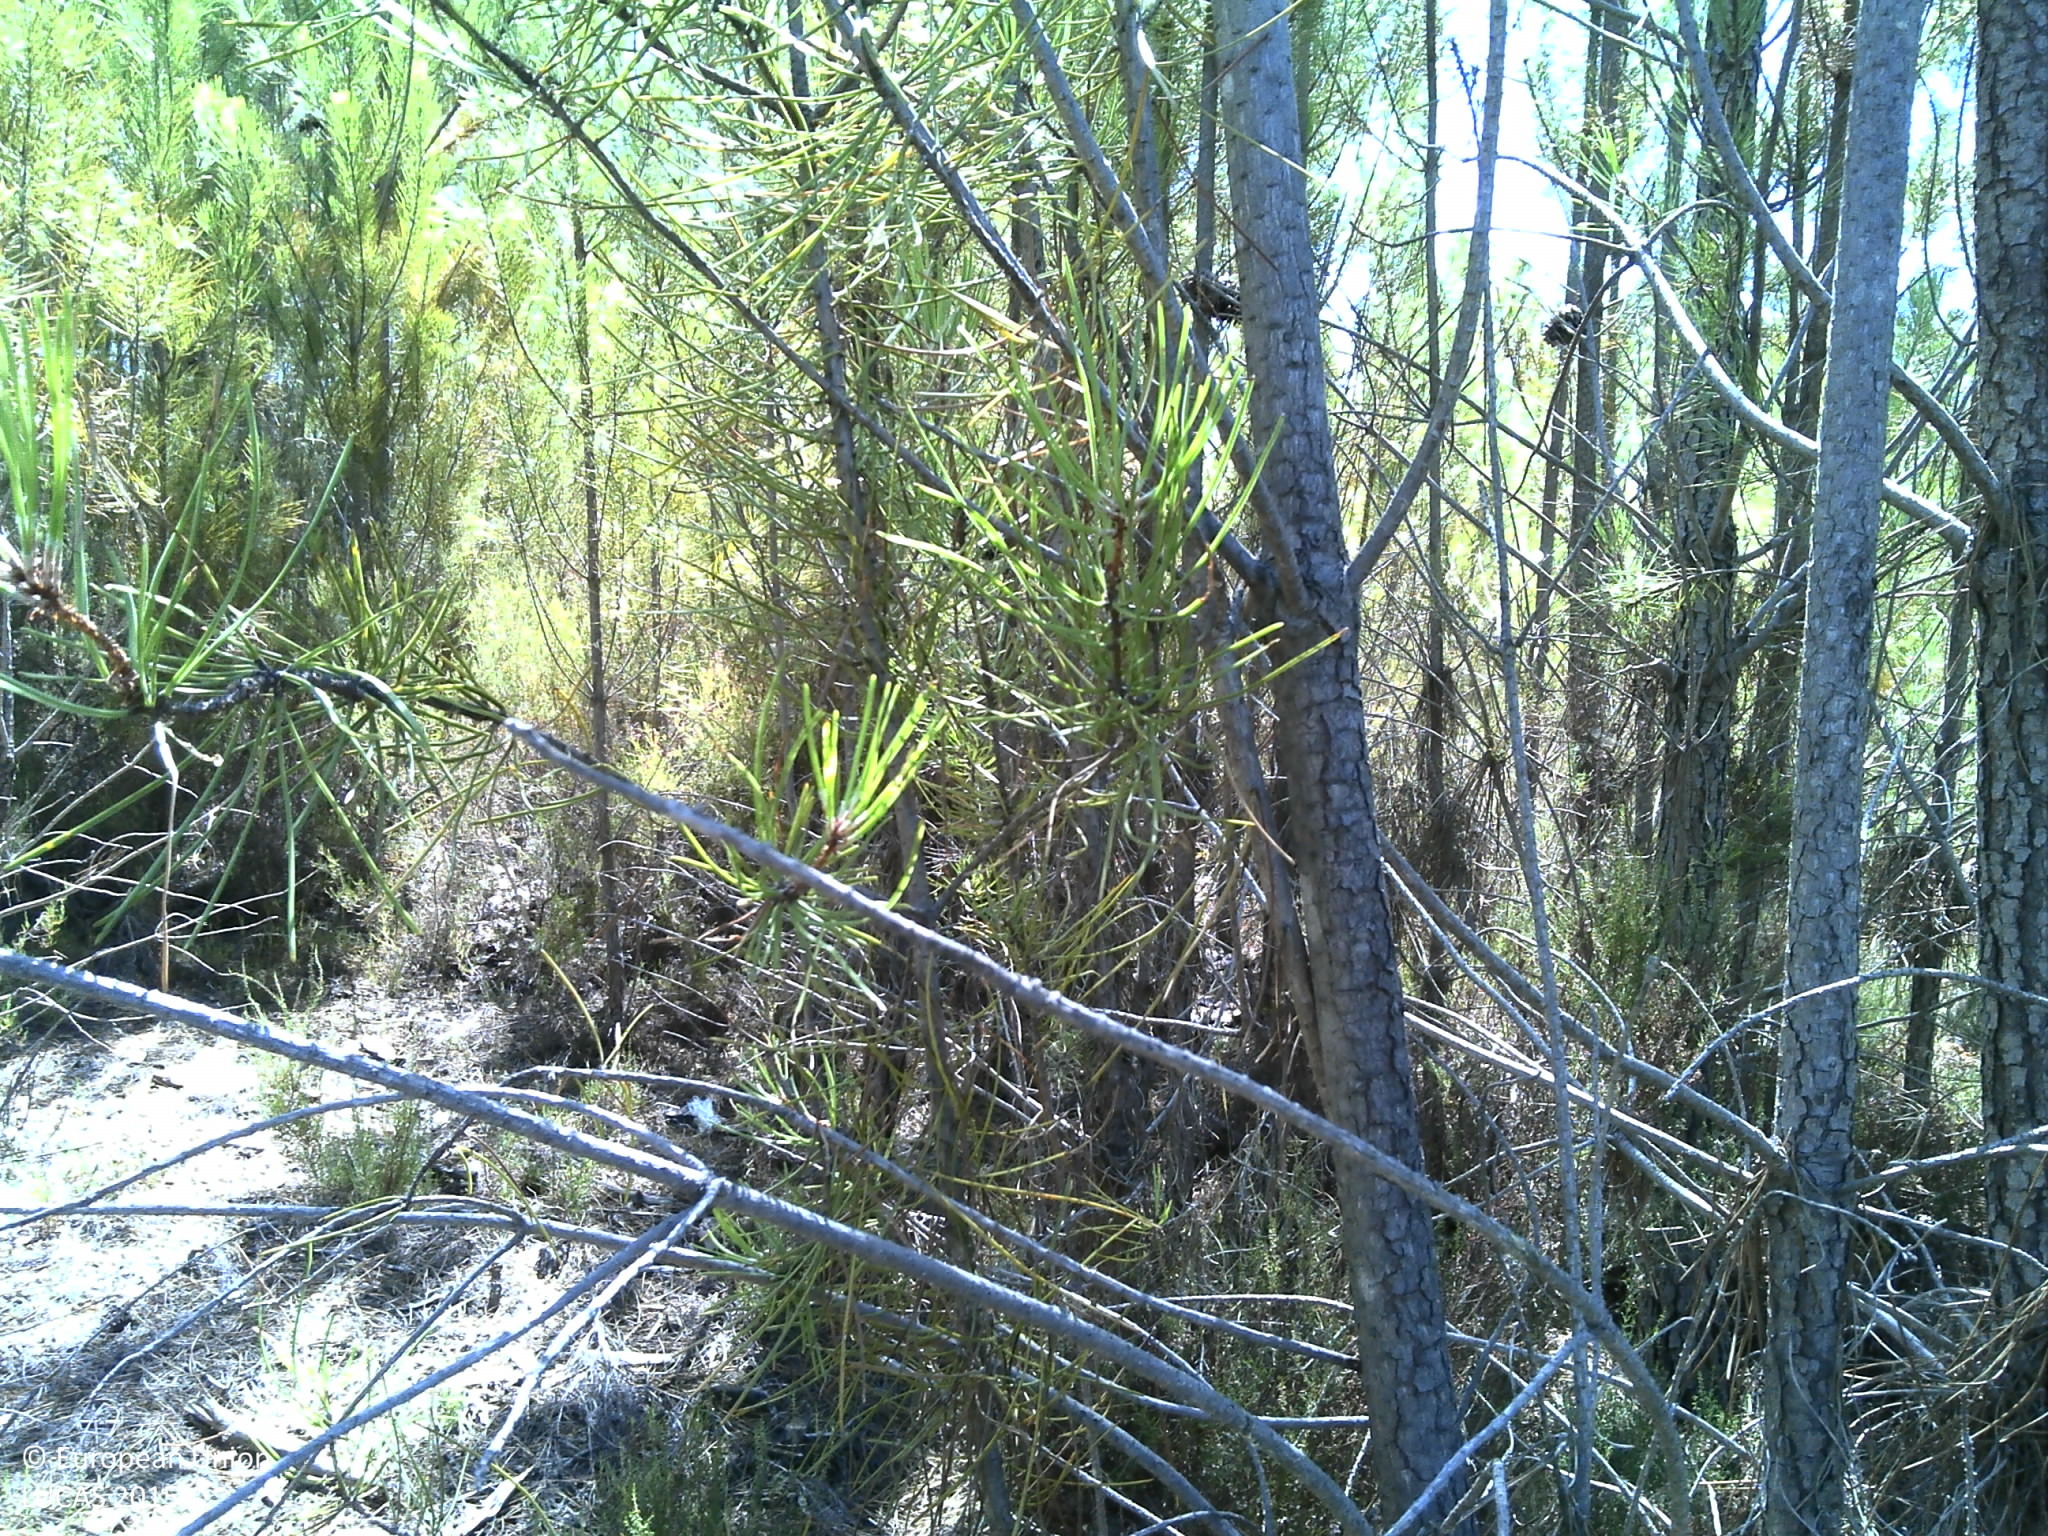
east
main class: Woodland
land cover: Pine dominated coniferous woodland
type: coniferous forest of the mediterranean region
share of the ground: 50 - 75 %
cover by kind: coniferous forest trees 50 %, shrubs 40 %, unconsolidated bare surface 10 %
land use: Forestry
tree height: < 5 m
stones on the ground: > 50 %
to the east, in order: Pine dominated coniferous woodland; Tracks; Pine dominated coniferous woodland; Tracks; Grass margins; Dry stone walls; Olive groves; Tracks; Dry stone walls; Olive groves; Artificial constructions in urban areas; Olive groves; Shrubland with sparse tree cover
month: July
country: PT
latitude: 39.7848
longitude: -7.8200
